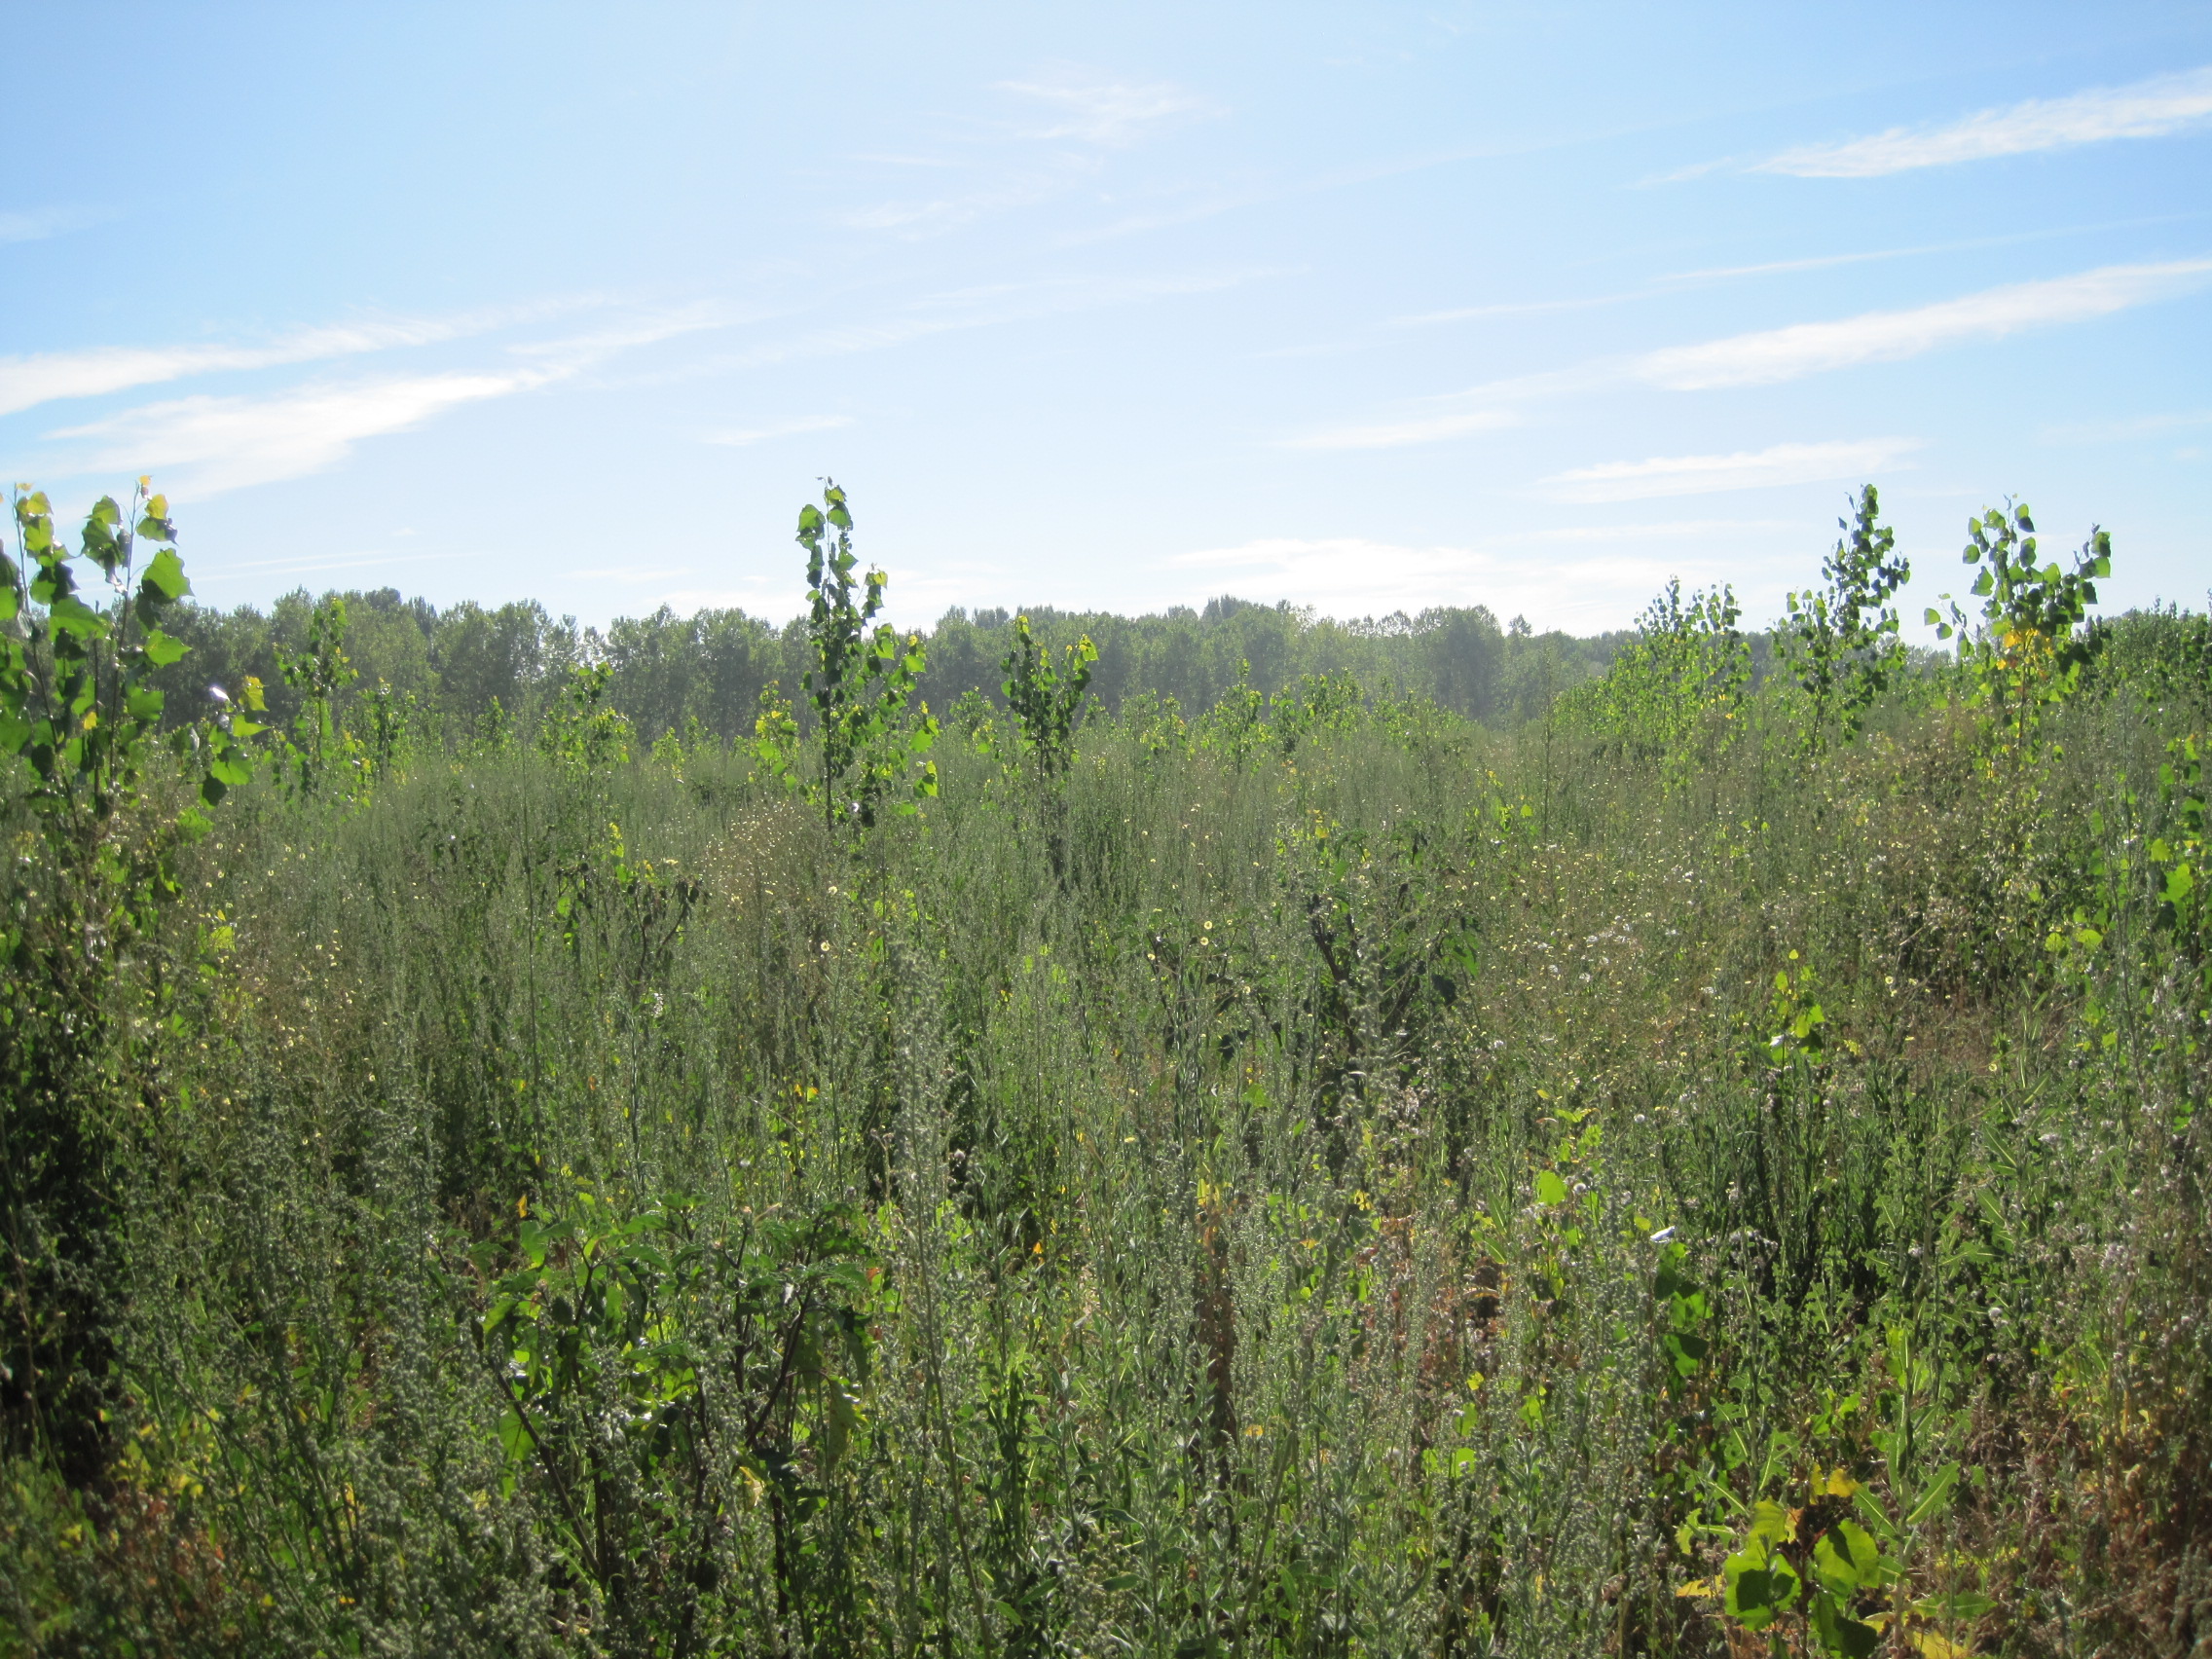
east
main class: Woodland
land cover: Broadleaved woodland
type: exotic forest
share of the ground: 25 - 50 %
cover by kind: shrubs 50 %, broadleaved forest trees 25 %, herbaceous plants 25 %
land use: Forestry
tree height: < 5 m
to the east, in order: Broadleaved woodland; Tracks; Broadleaved woodland
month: July
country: ES
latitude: 42.0403
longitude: -5.6143
